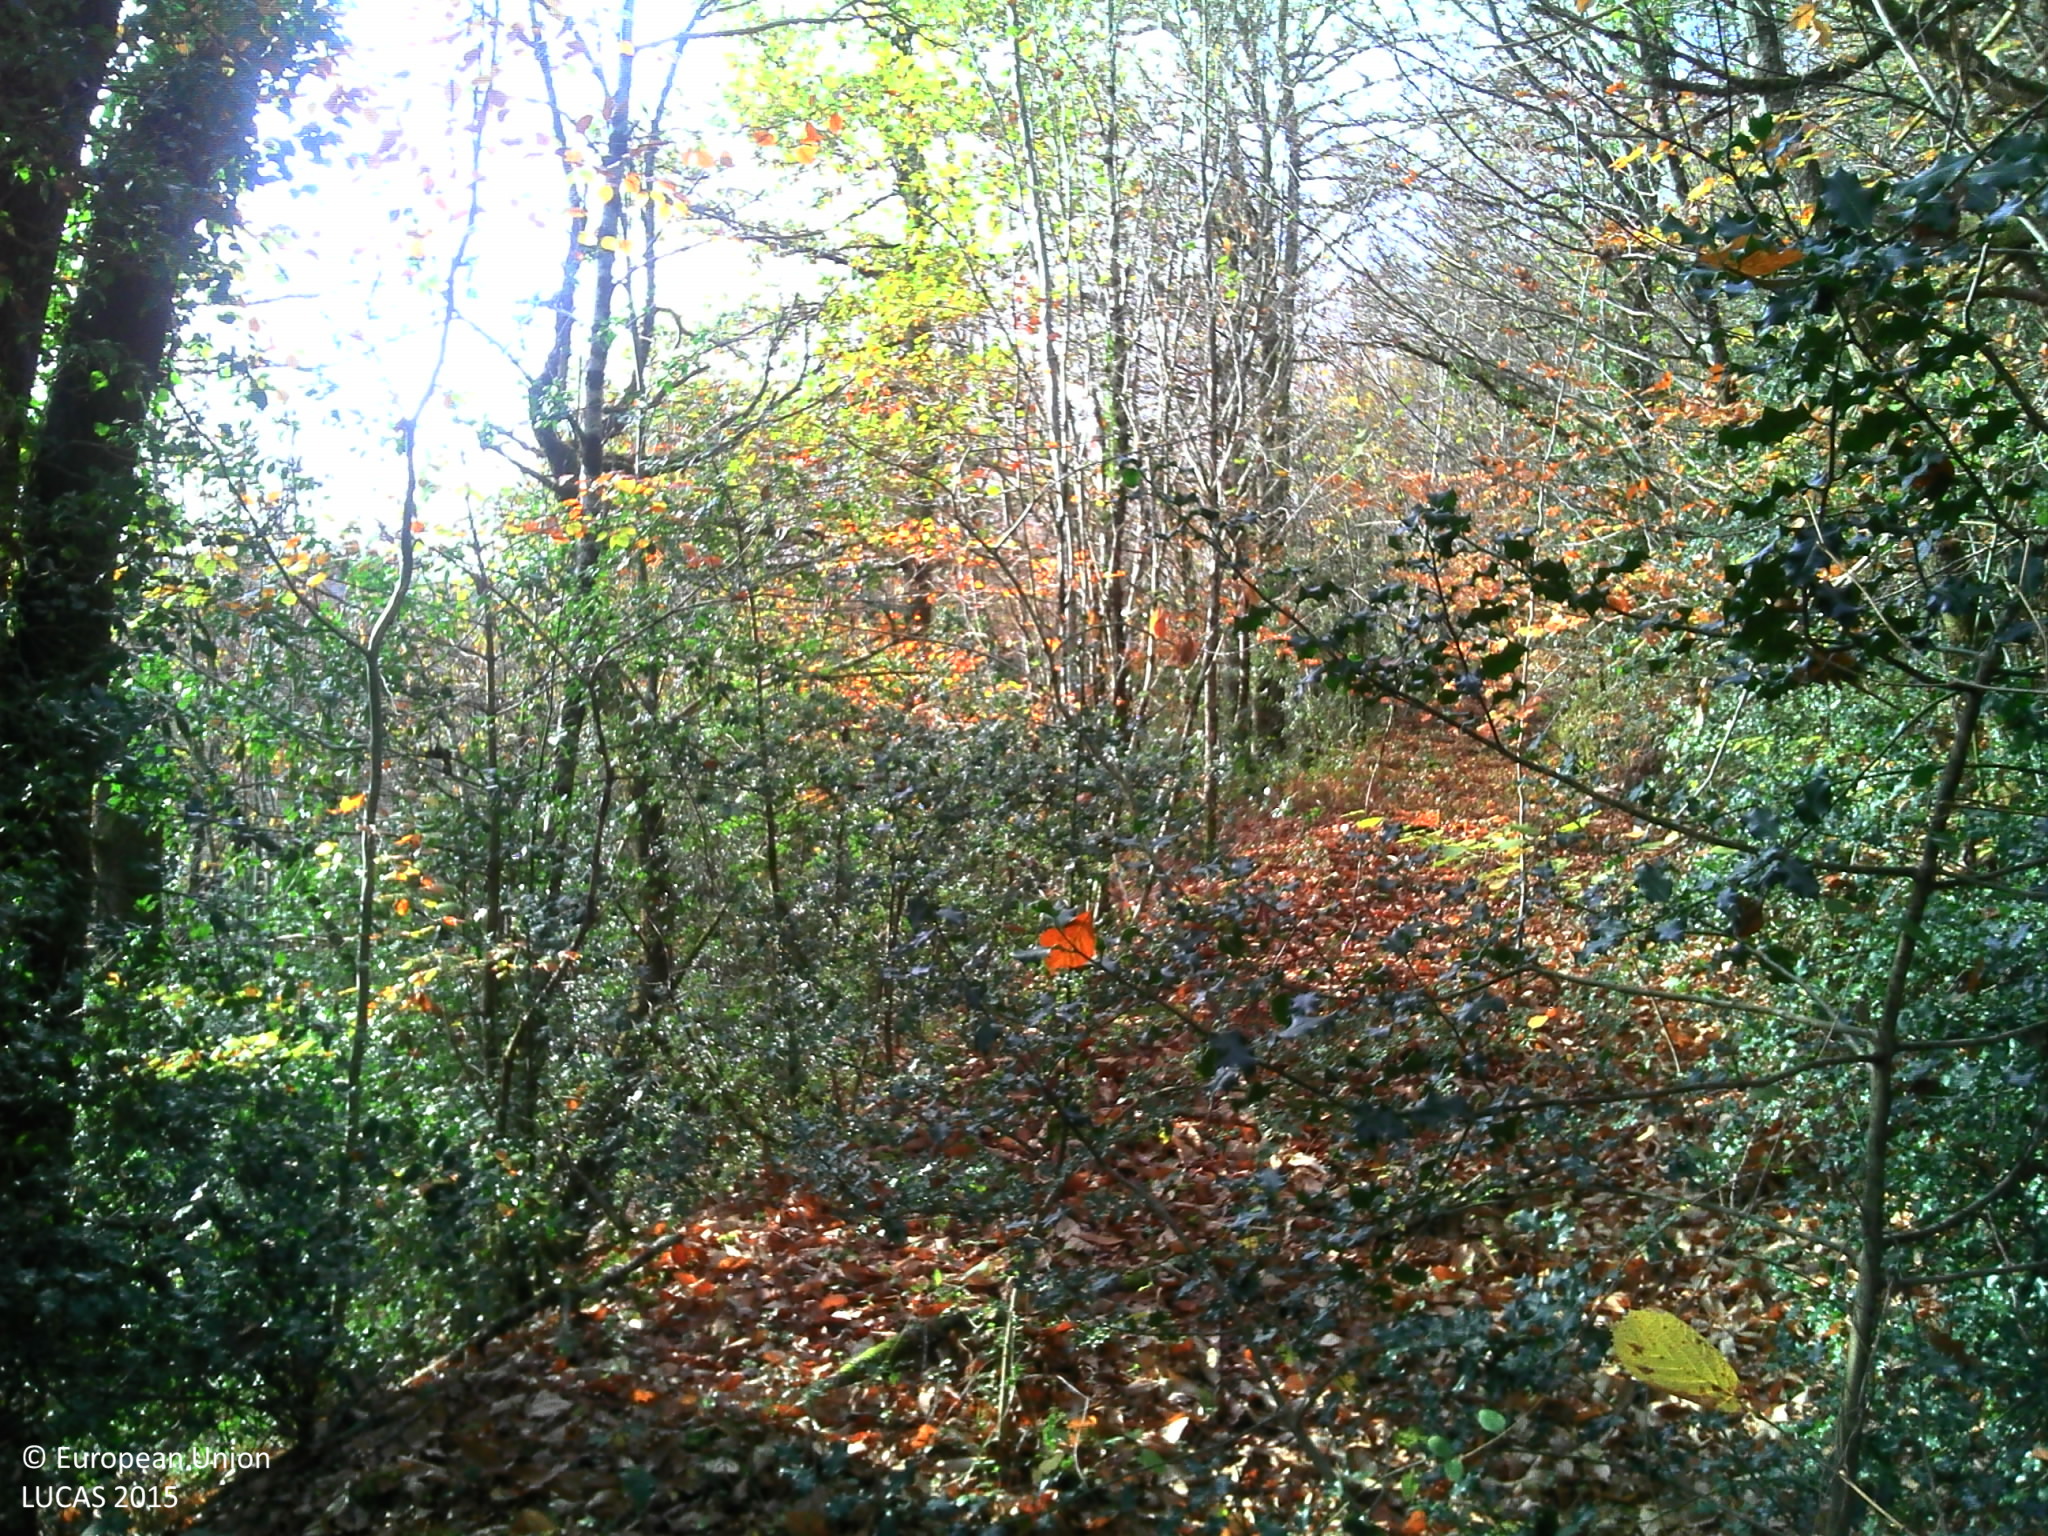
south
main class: Woodland
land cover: Broadleaved woodland
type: thermophilous deciduous forest
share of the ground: > 75 %
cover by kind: broadleaved forest trees 80 %, shrubs 5 %, herbaceous plants 5 %, lichens and mosses 5 %
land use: Forestry
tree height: > 5 m
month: November
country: FR
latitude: 45.4029
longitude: 1.8065
